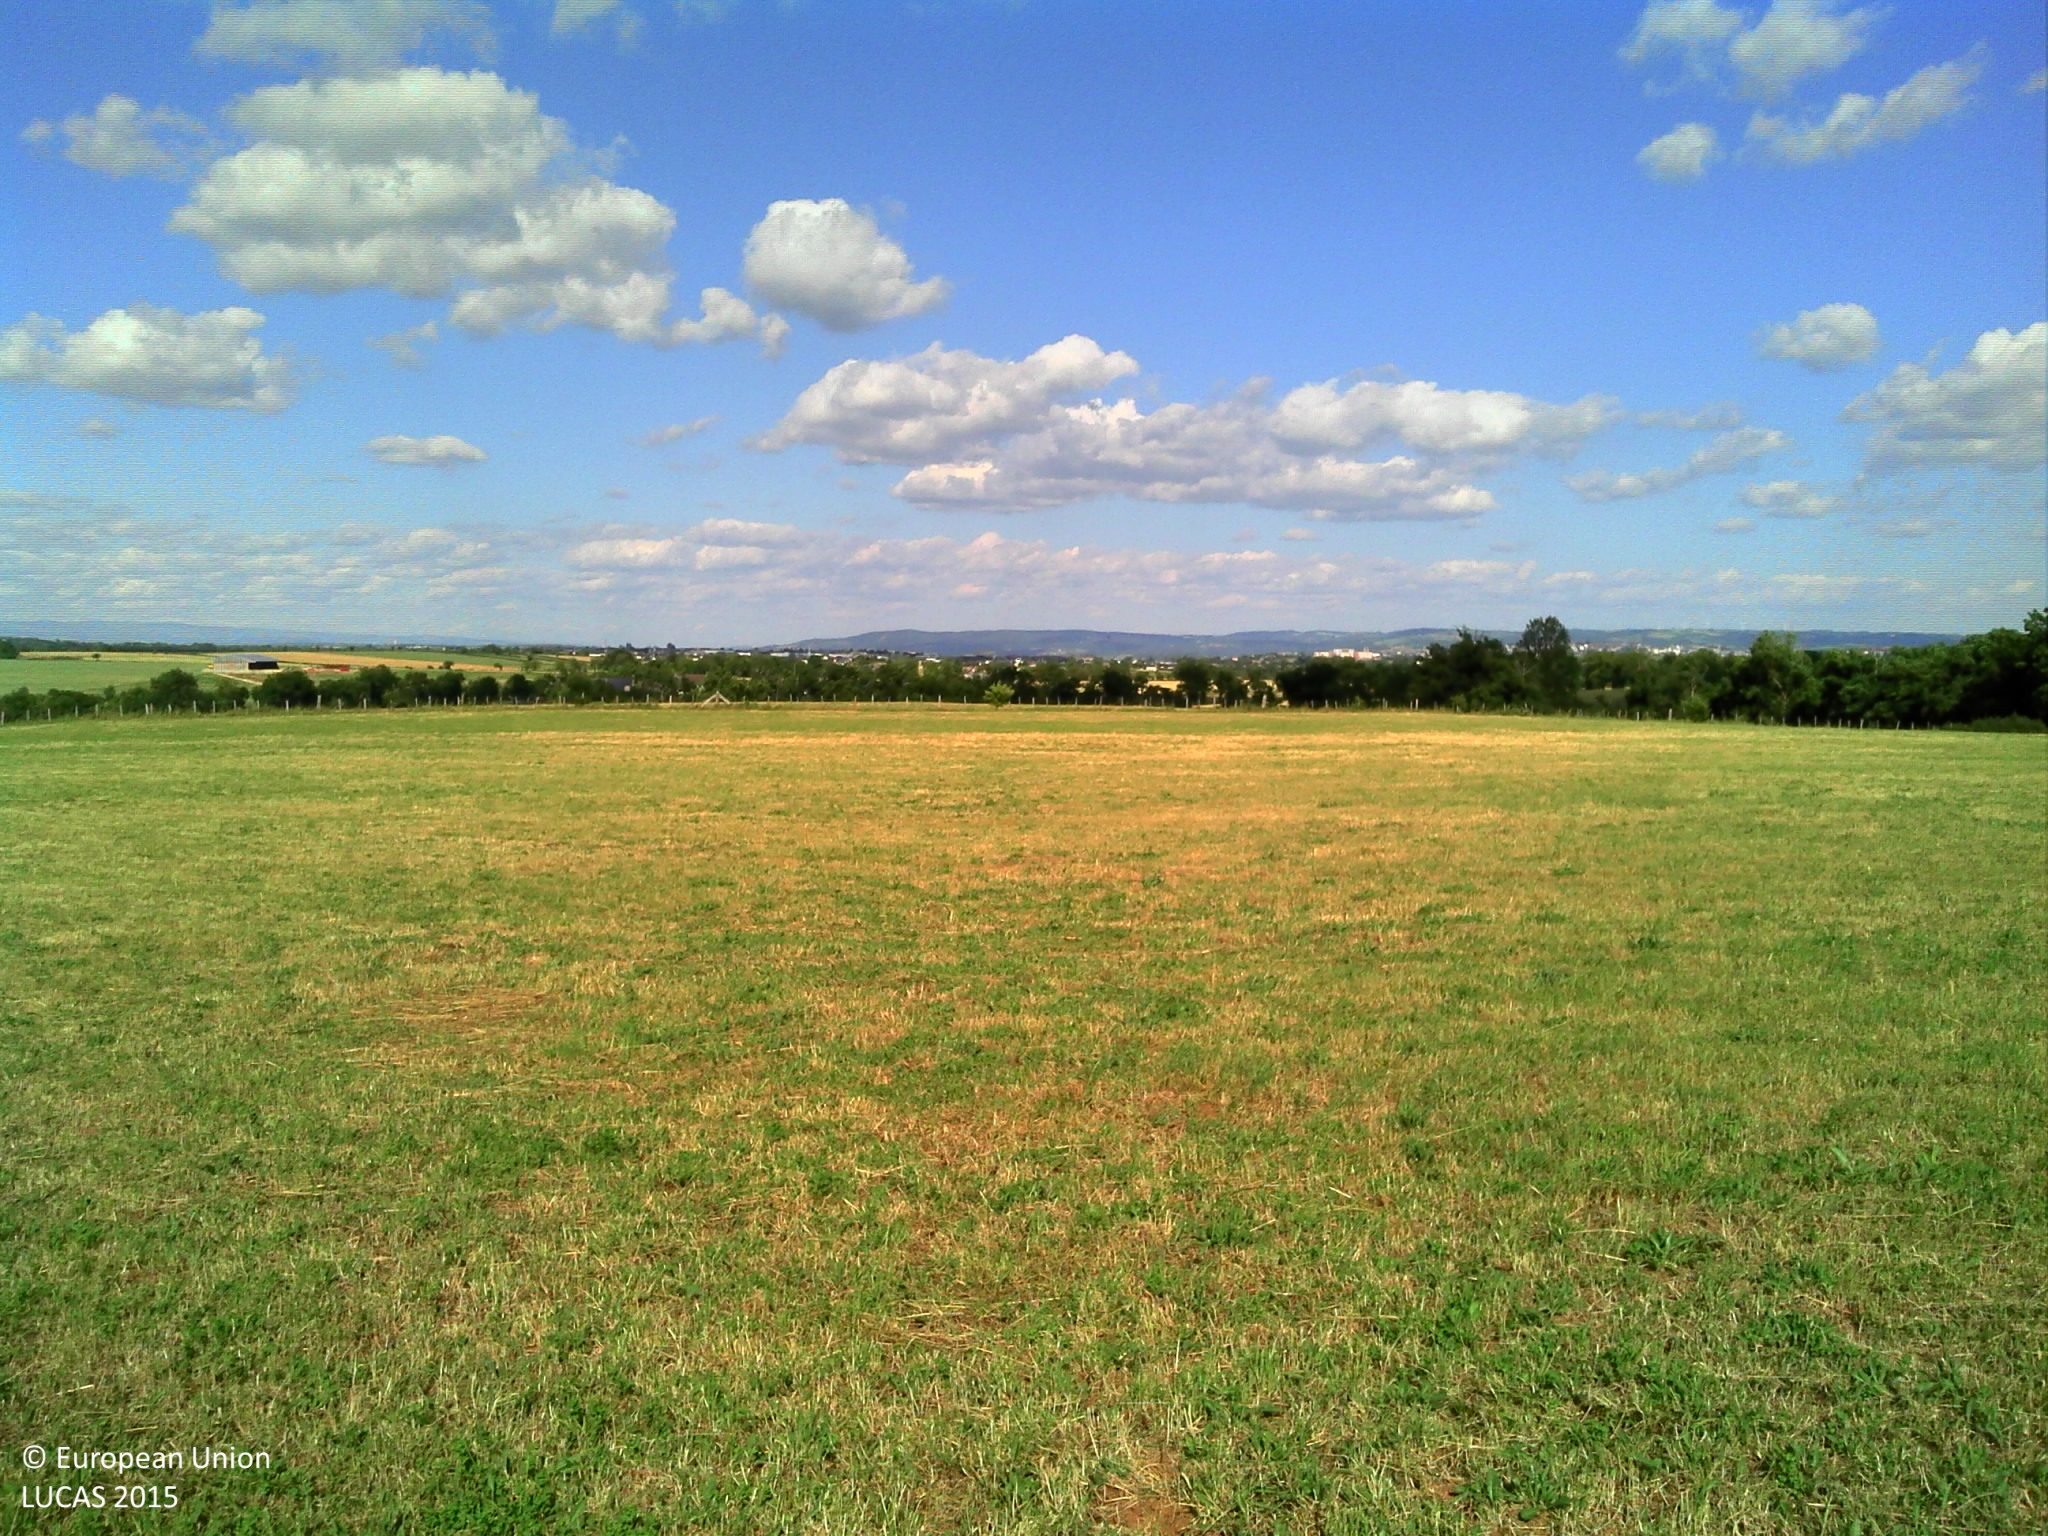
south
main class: Grassland
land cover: Grassland without tree/shrub cover
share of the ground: > 75 %
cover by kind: herbaceous plants 100 %
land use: Agriculture (excluding fallow land and kitchen gardens)
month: June
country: FR
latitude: 44.3676
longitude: 2.4864
